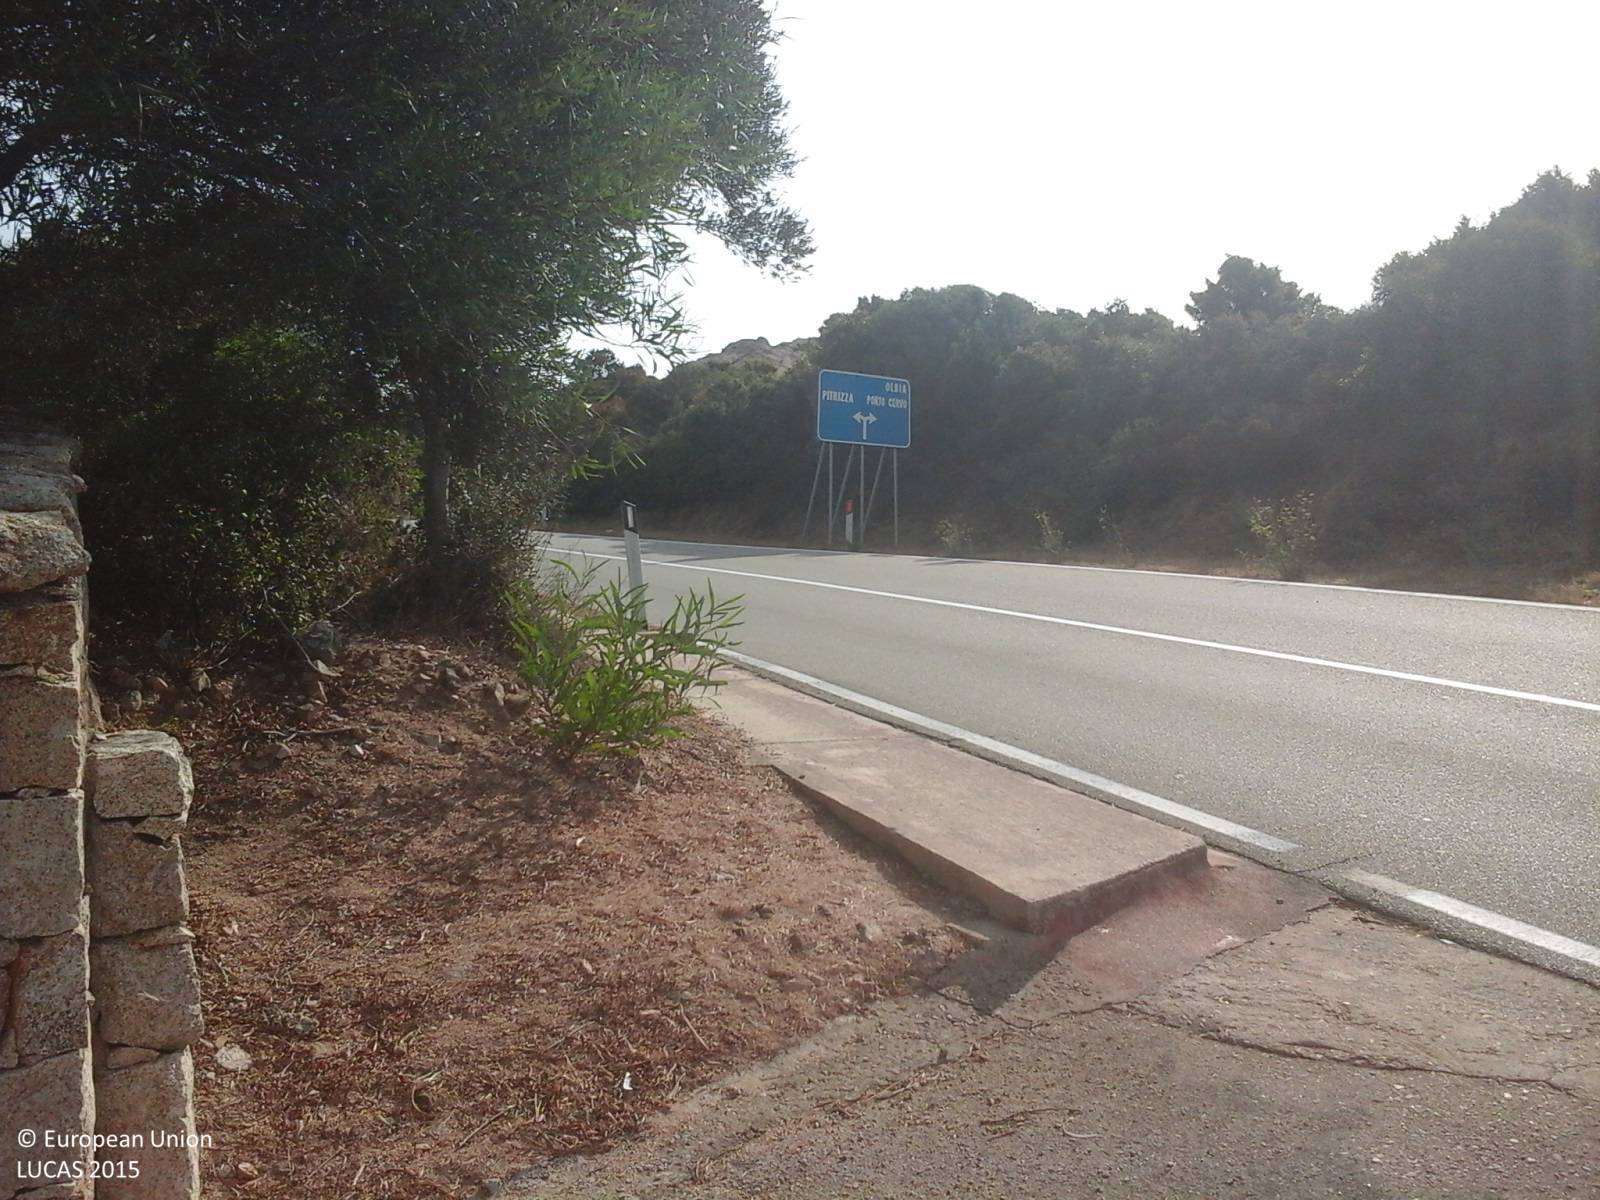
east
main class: Woodland
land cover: Broadleaved woodland
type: broadleaved evergreen forest
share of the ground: > 75 %
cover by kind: broadleaved forest trees 90 %, shrubs 5 %, unconsolidated bare surface 5 %
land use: Residential
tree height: > 5 m
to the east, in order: Broadleaved woodland; Dry stone walls; Broadleaved woodland; Grass margins; Paved roads, cycling and walking lanes; Grass margins; Broadleaved woodland; Tracks; Rocks and stones; Shrubland with sparse tree cover; Rocks and stones; Shrubland with sparse tree cover
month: September
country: IT
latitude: 41.1347
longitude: 9.5138
